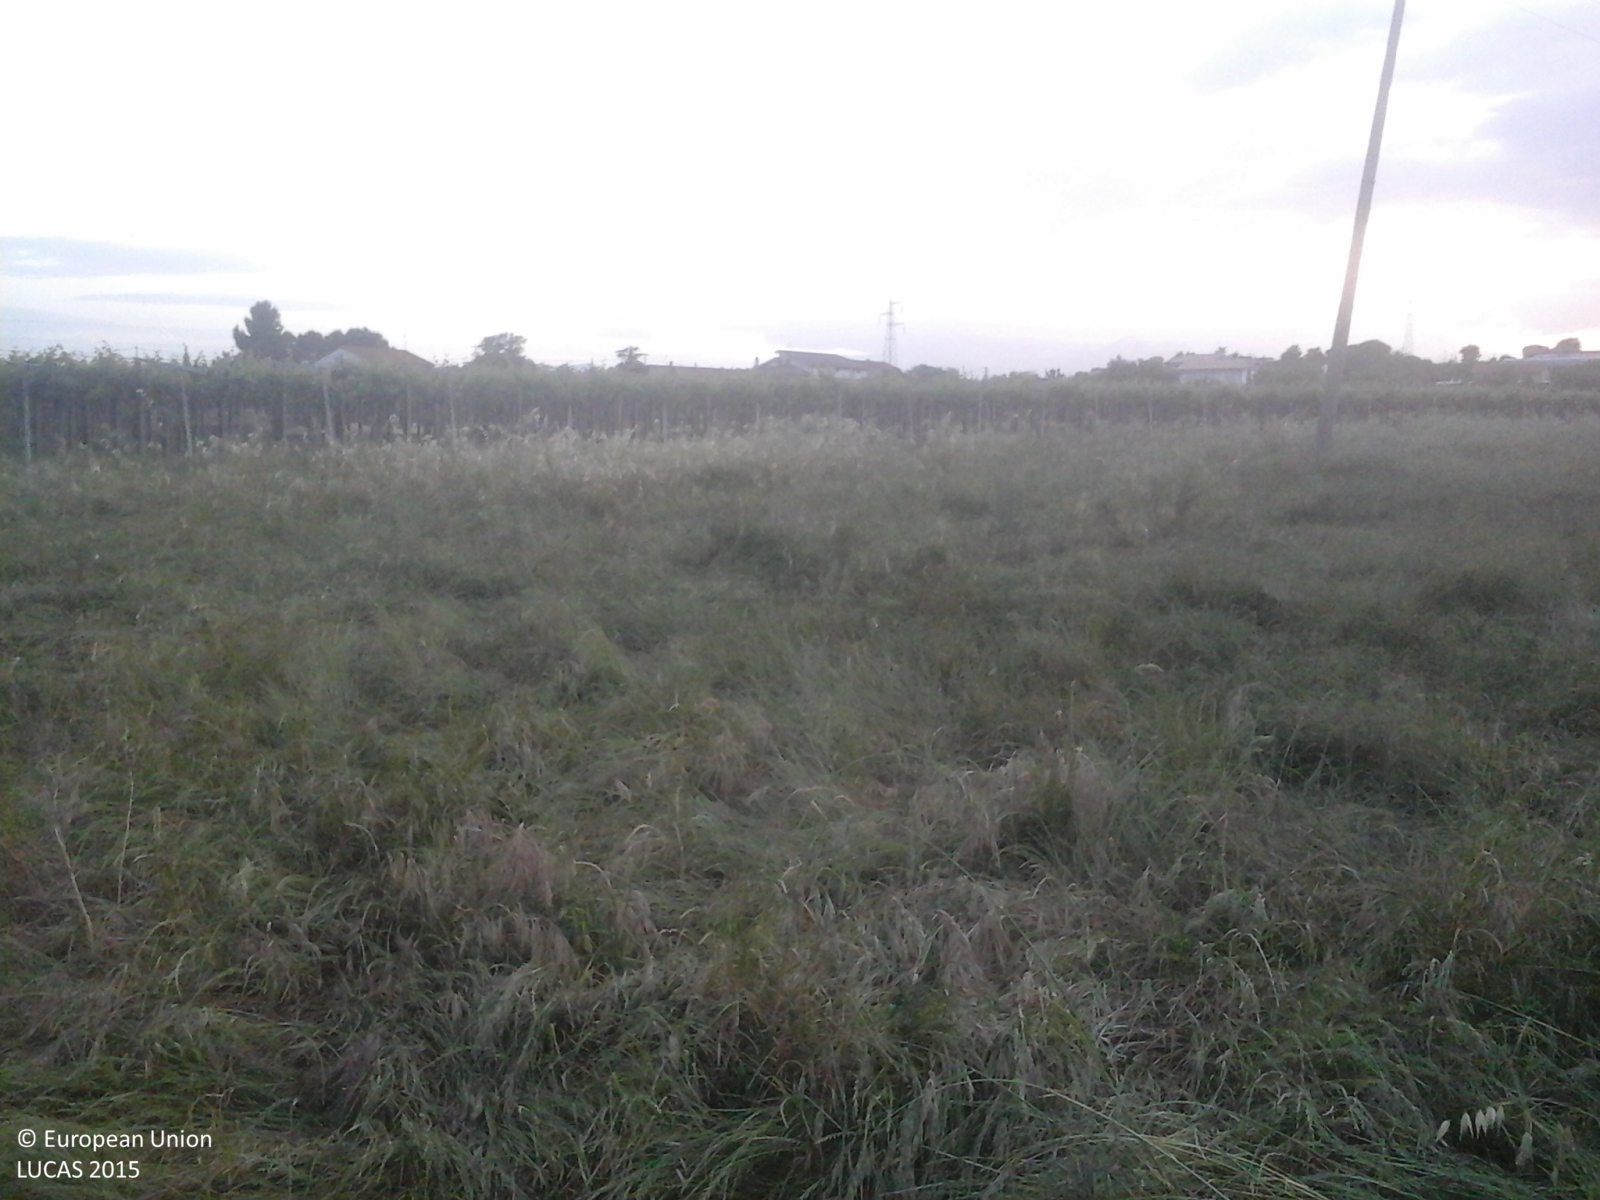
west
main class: Grassland
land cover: Spontaneously vegetated surfaces
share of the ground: > 75 %
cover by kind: herbaceous plants 100 %
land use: Fallow land
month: May
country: IT
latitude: 42.0965
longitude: 14.6166
